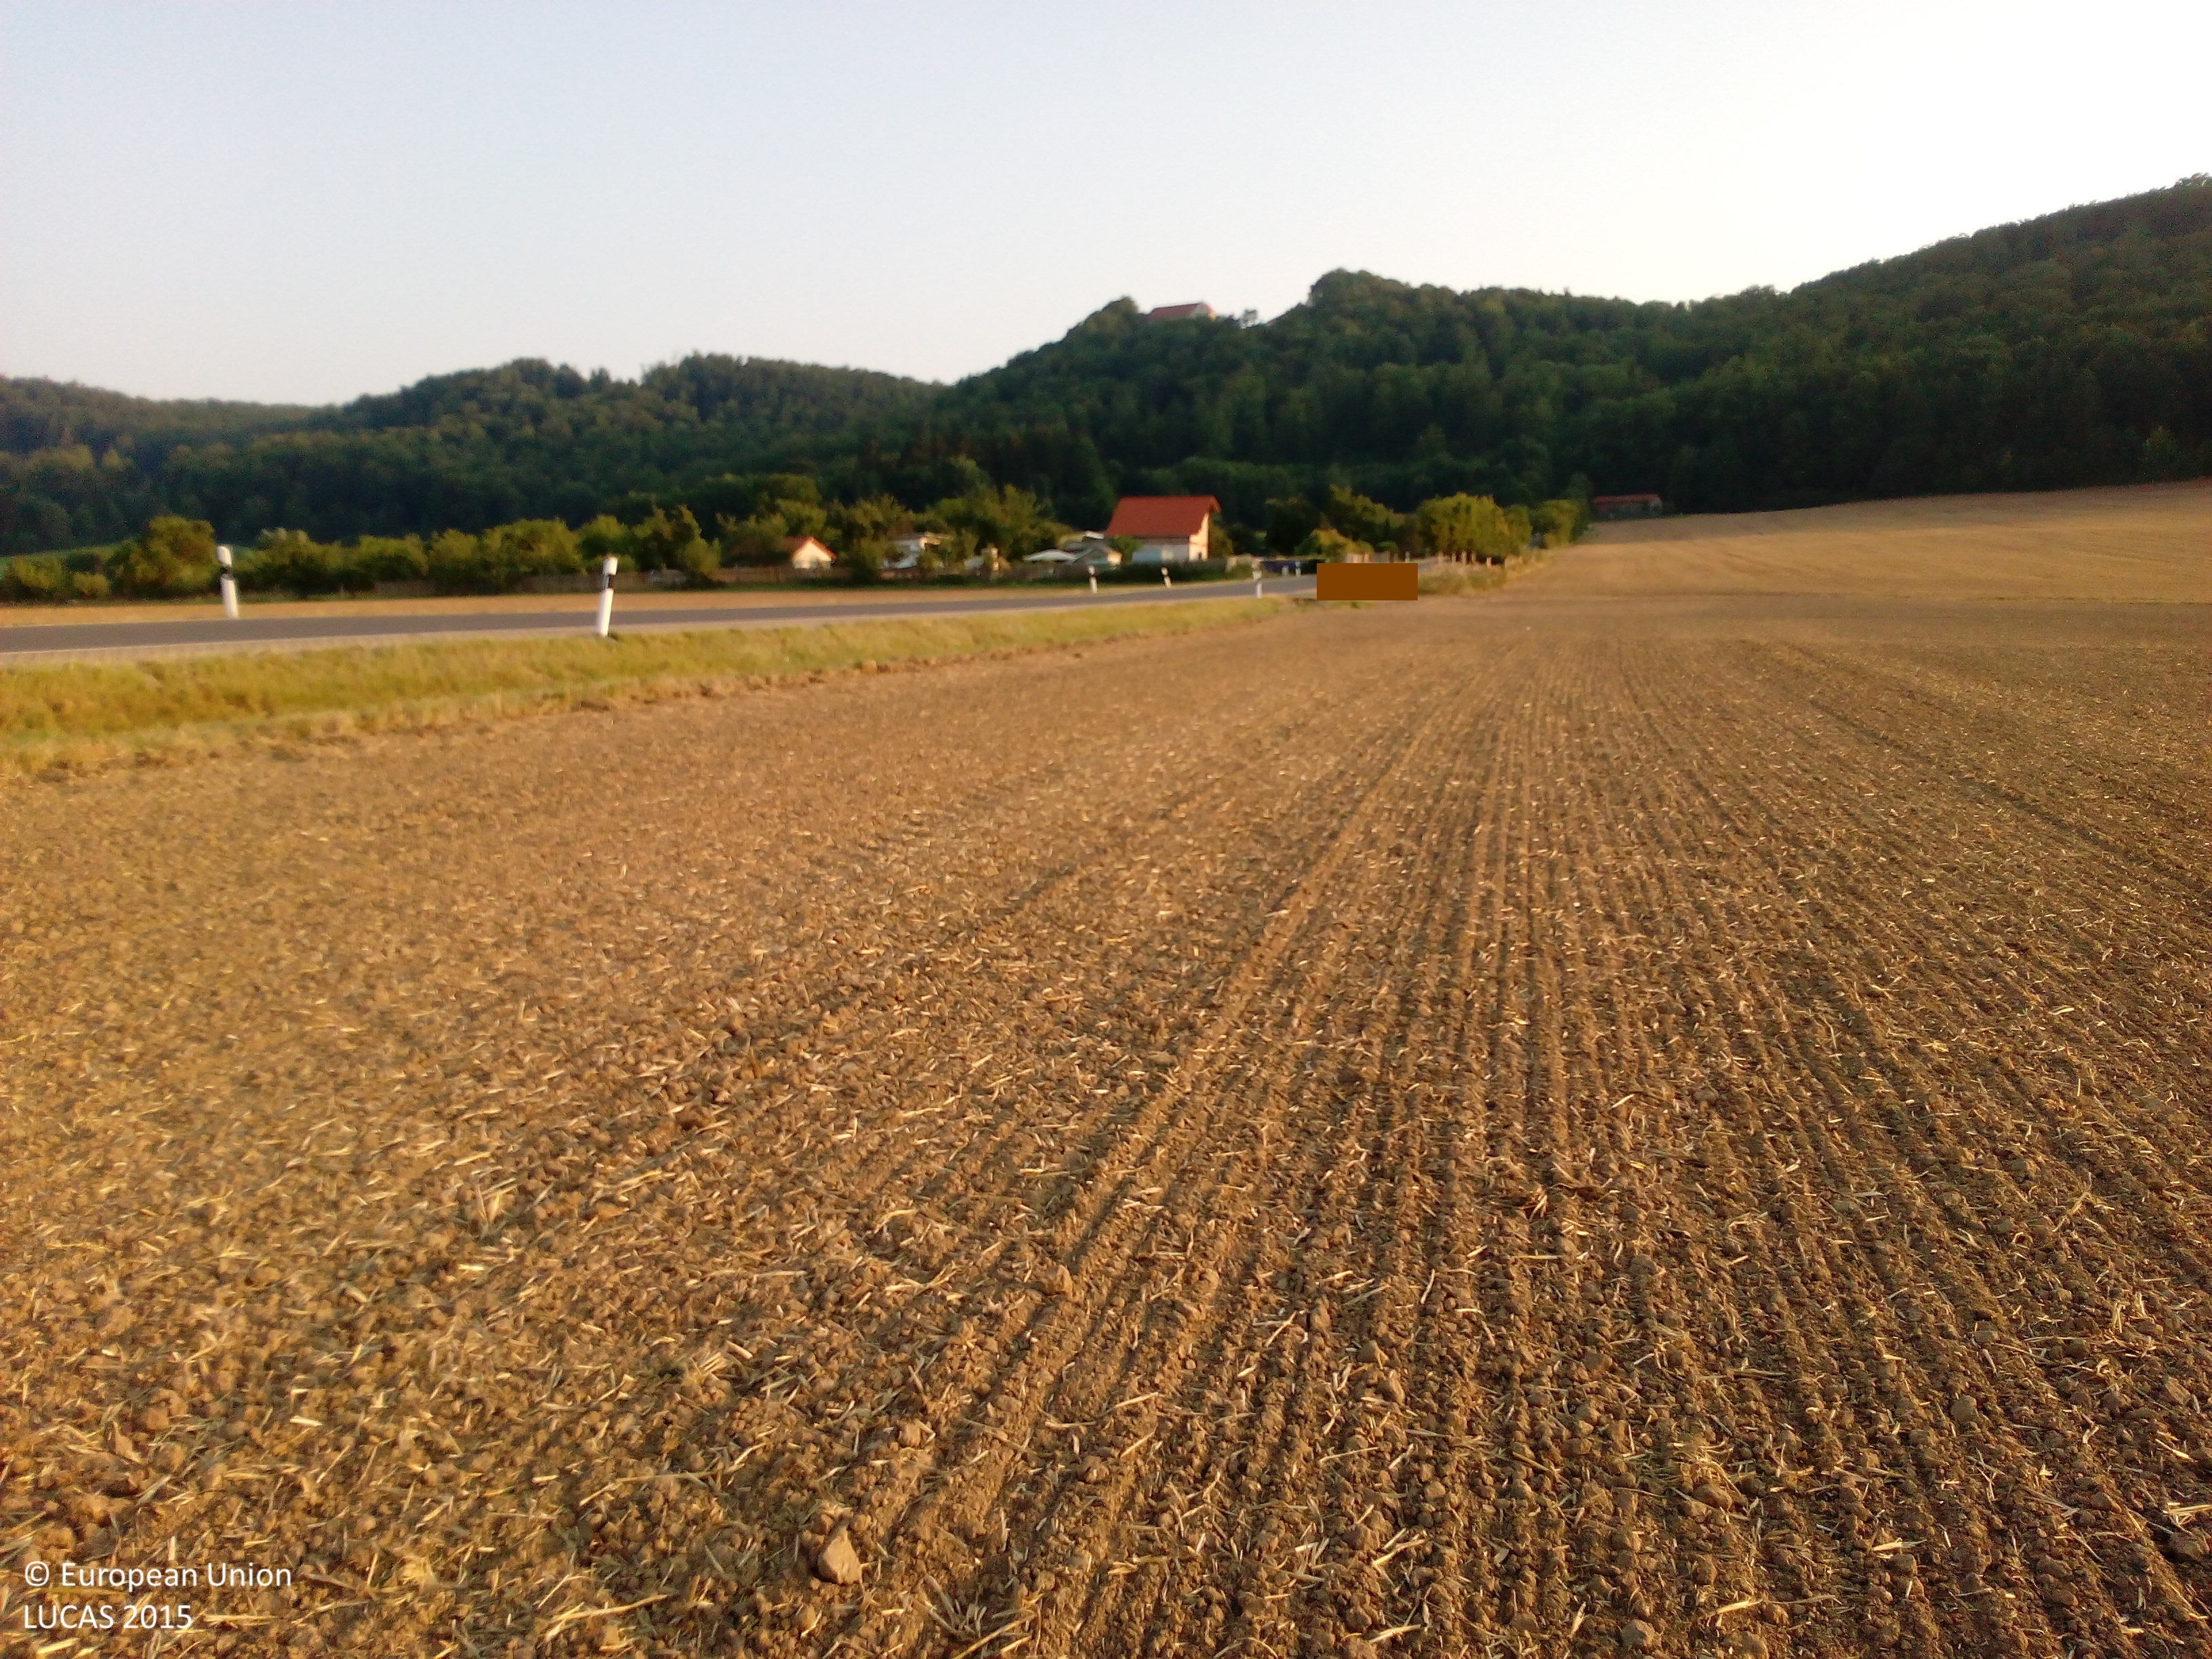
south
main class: Cropland
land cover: Barley
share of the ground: < 10 %
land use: Agriculture (excluding fallow land and kitchen gardens)
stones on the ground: < 10 %
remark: Harvested field
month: August
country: DE
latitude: 51.3705
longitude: 10.2728
